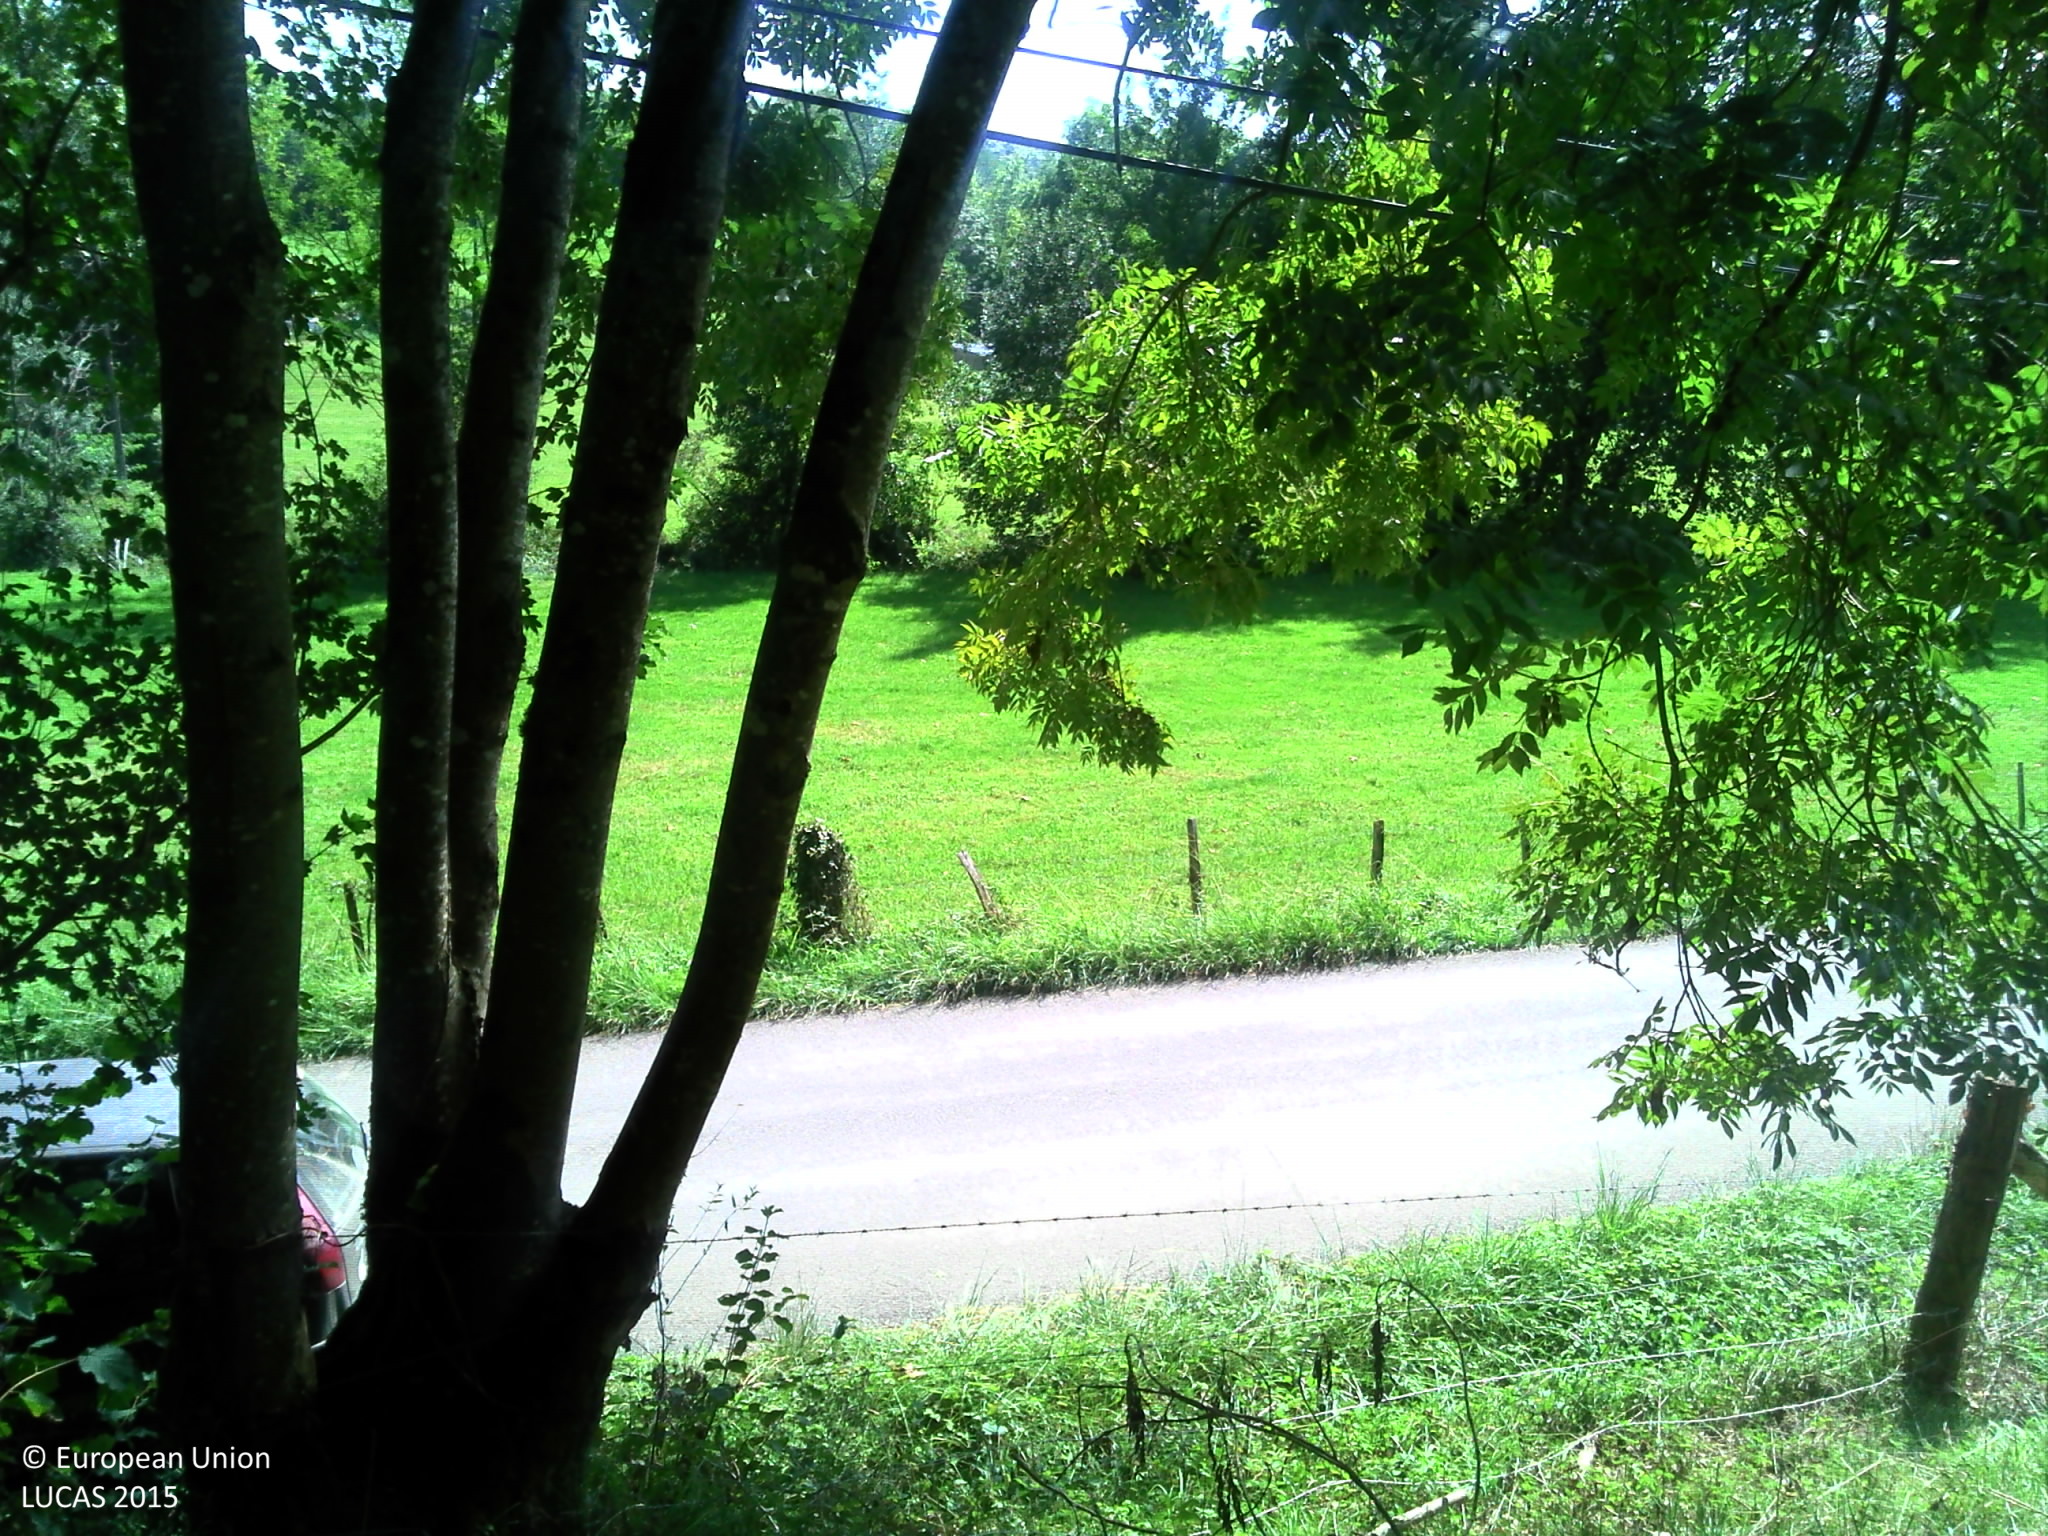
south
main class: Grassland
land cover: Grassland without tree/shrub cover
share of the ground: > 75 %
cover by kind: herbaceous plants 100 %
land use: Agriculture (excluding fallow land and kitchen gardens)
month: September
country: FR
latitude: 43.1872
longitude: -0.9492
